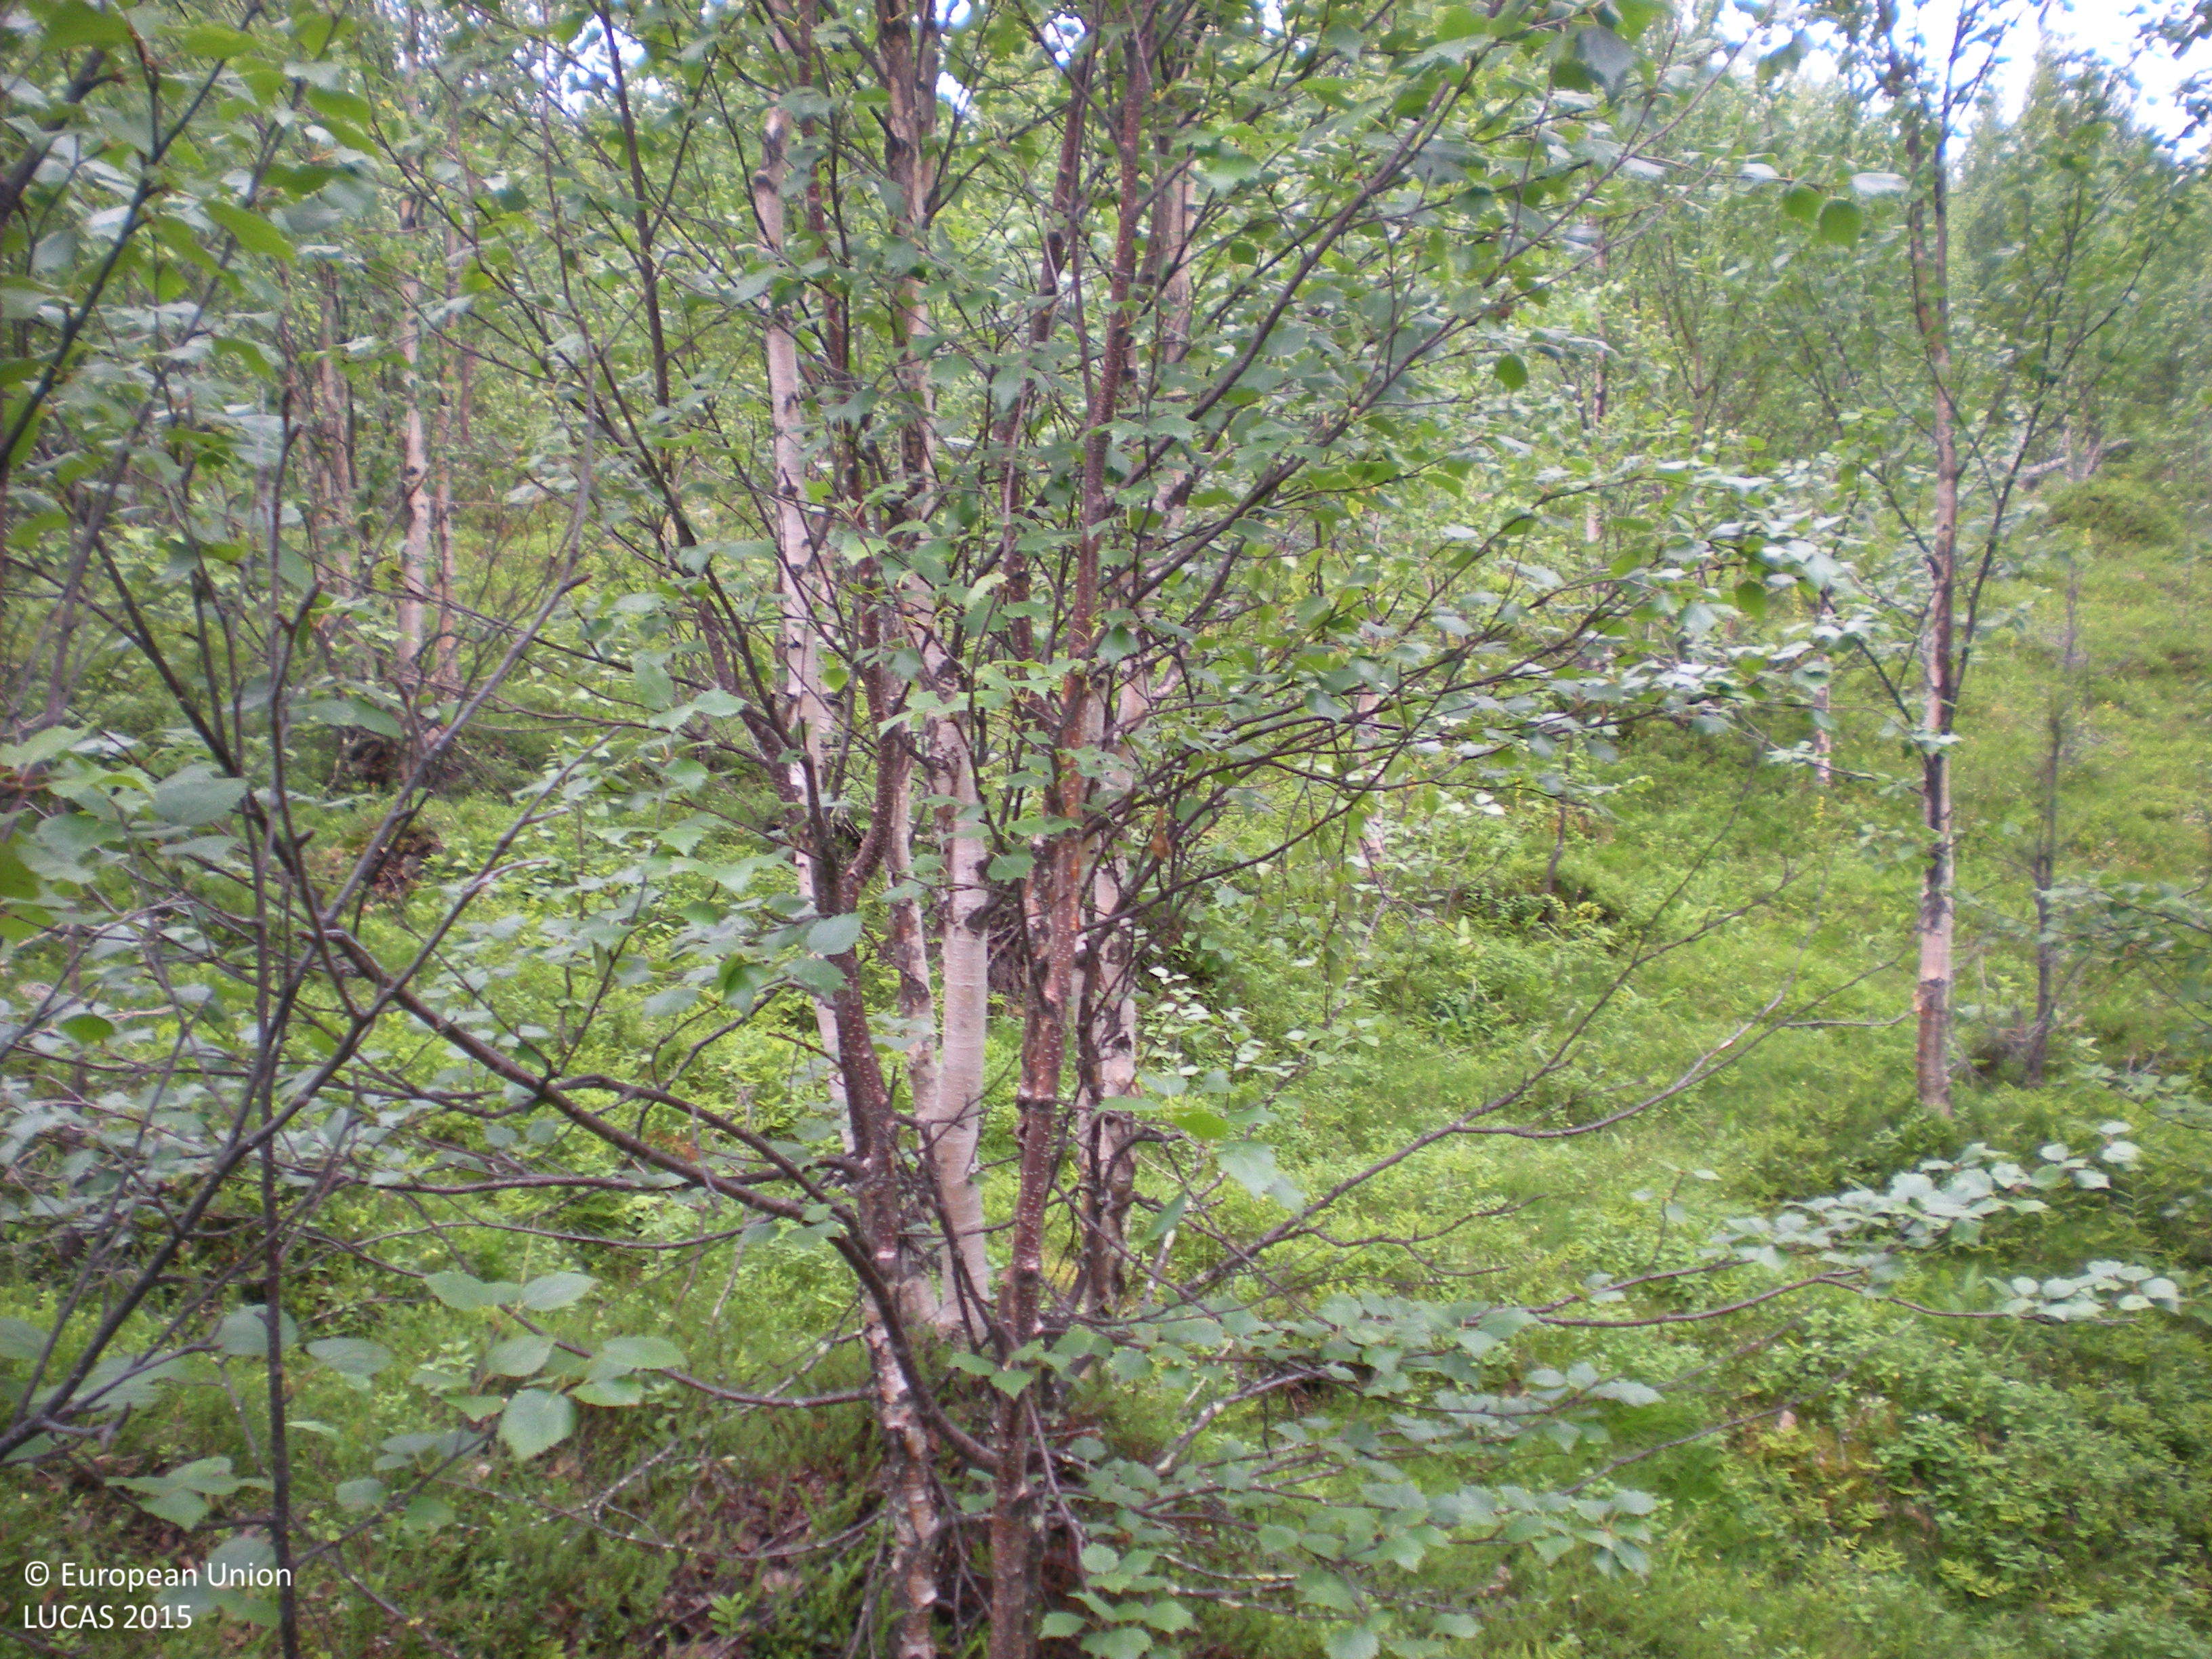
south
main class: Woodland
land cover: Broadleaved woodland
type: boreal forest
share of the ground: 50 - 75 %
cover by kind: broadleaved forest trees 65 %, herbaceous plants 20 %, shrubs 10 %, lichens and mosses 5 %
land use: Forestry
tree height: < 5 m
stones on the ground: > 50 %
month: August
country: SE
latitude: 66.2613
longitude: 17.3670
